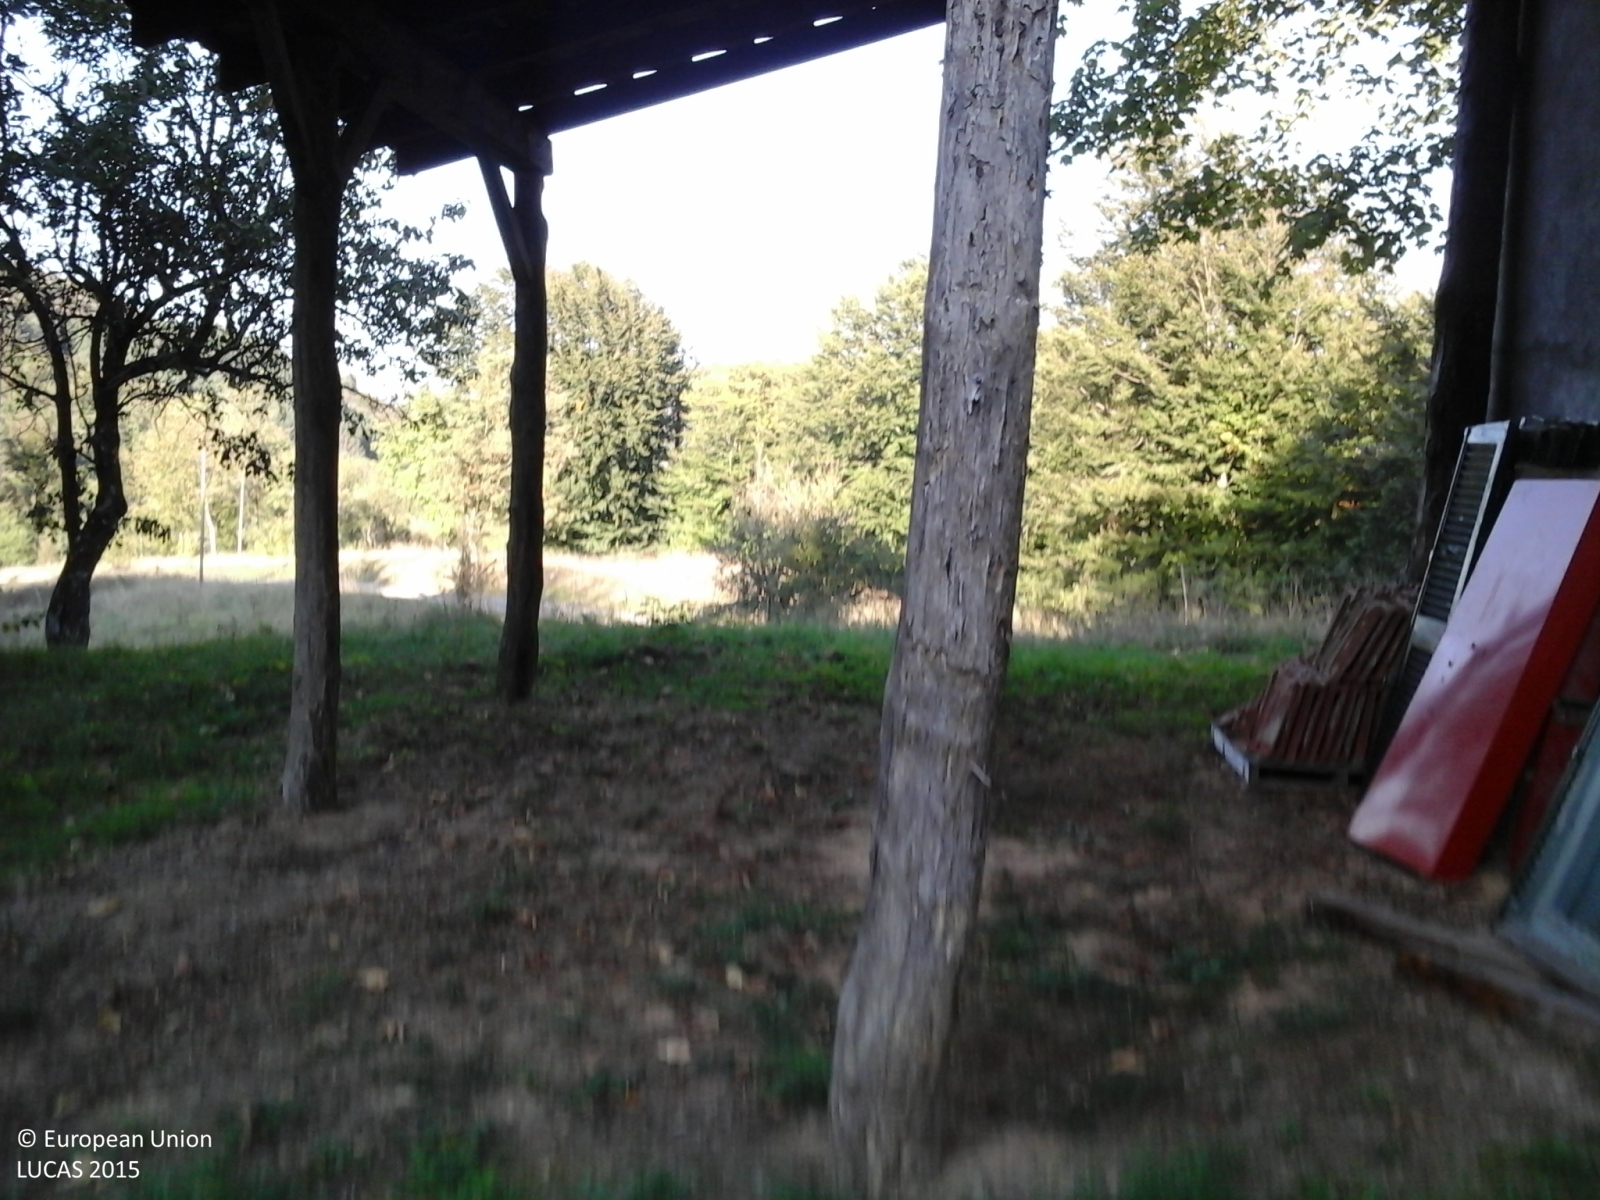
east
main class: Grassland
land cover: Grassland with sparse tree/shrub cover
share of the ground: > 75 %
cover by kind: herbaceous plants 85 %, shrubs 10 %, broadleaved forest trees 5 %
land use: Residential
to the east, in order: Grassland with sparse tree/shrub cover; Artificial constructions in urban areas; Broadleaved woodland; Rivers and streams; Broadleaved woodland
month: September
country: IT
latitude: 44.4105
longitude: 8.4087
